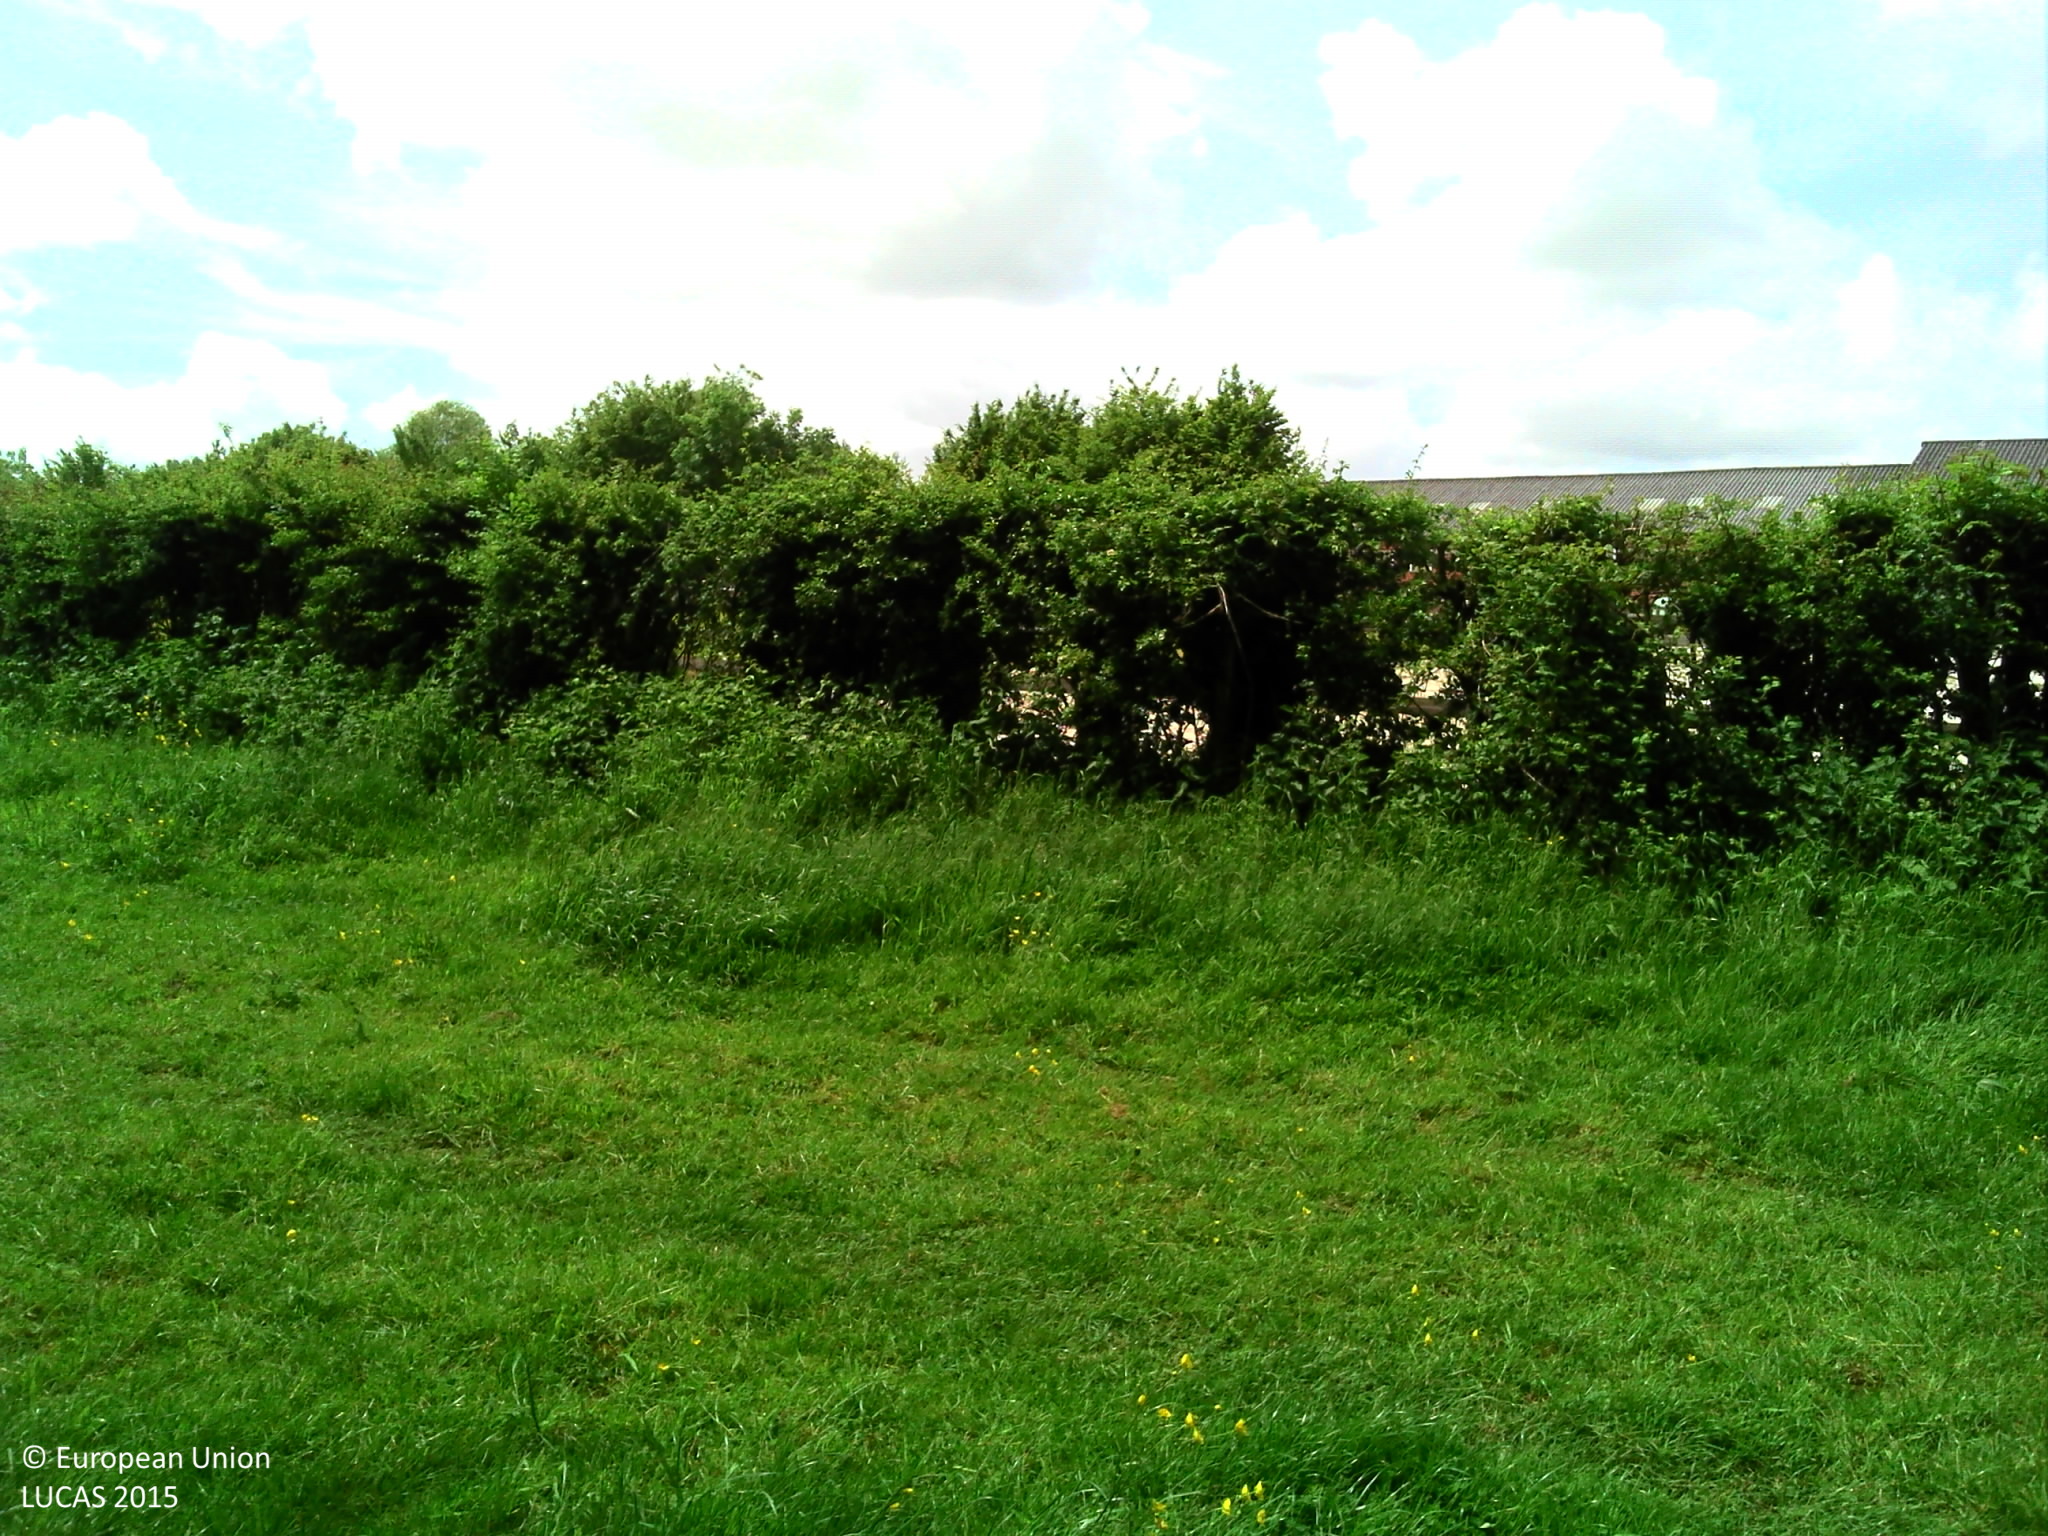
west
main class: Woodland
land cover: Broadleaved woodland
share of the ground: 50 - 75 %
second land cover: Grassland without tree/shrub cover
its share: 25 - 50 %
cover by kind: broadleaved forest trees 70 %, herbaceous plants 30 %
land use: Forestry
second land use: Agriculture (excluding fallow land and kitchen gardens)
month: May
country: FR
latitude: 50.5816
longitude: 2.1471
